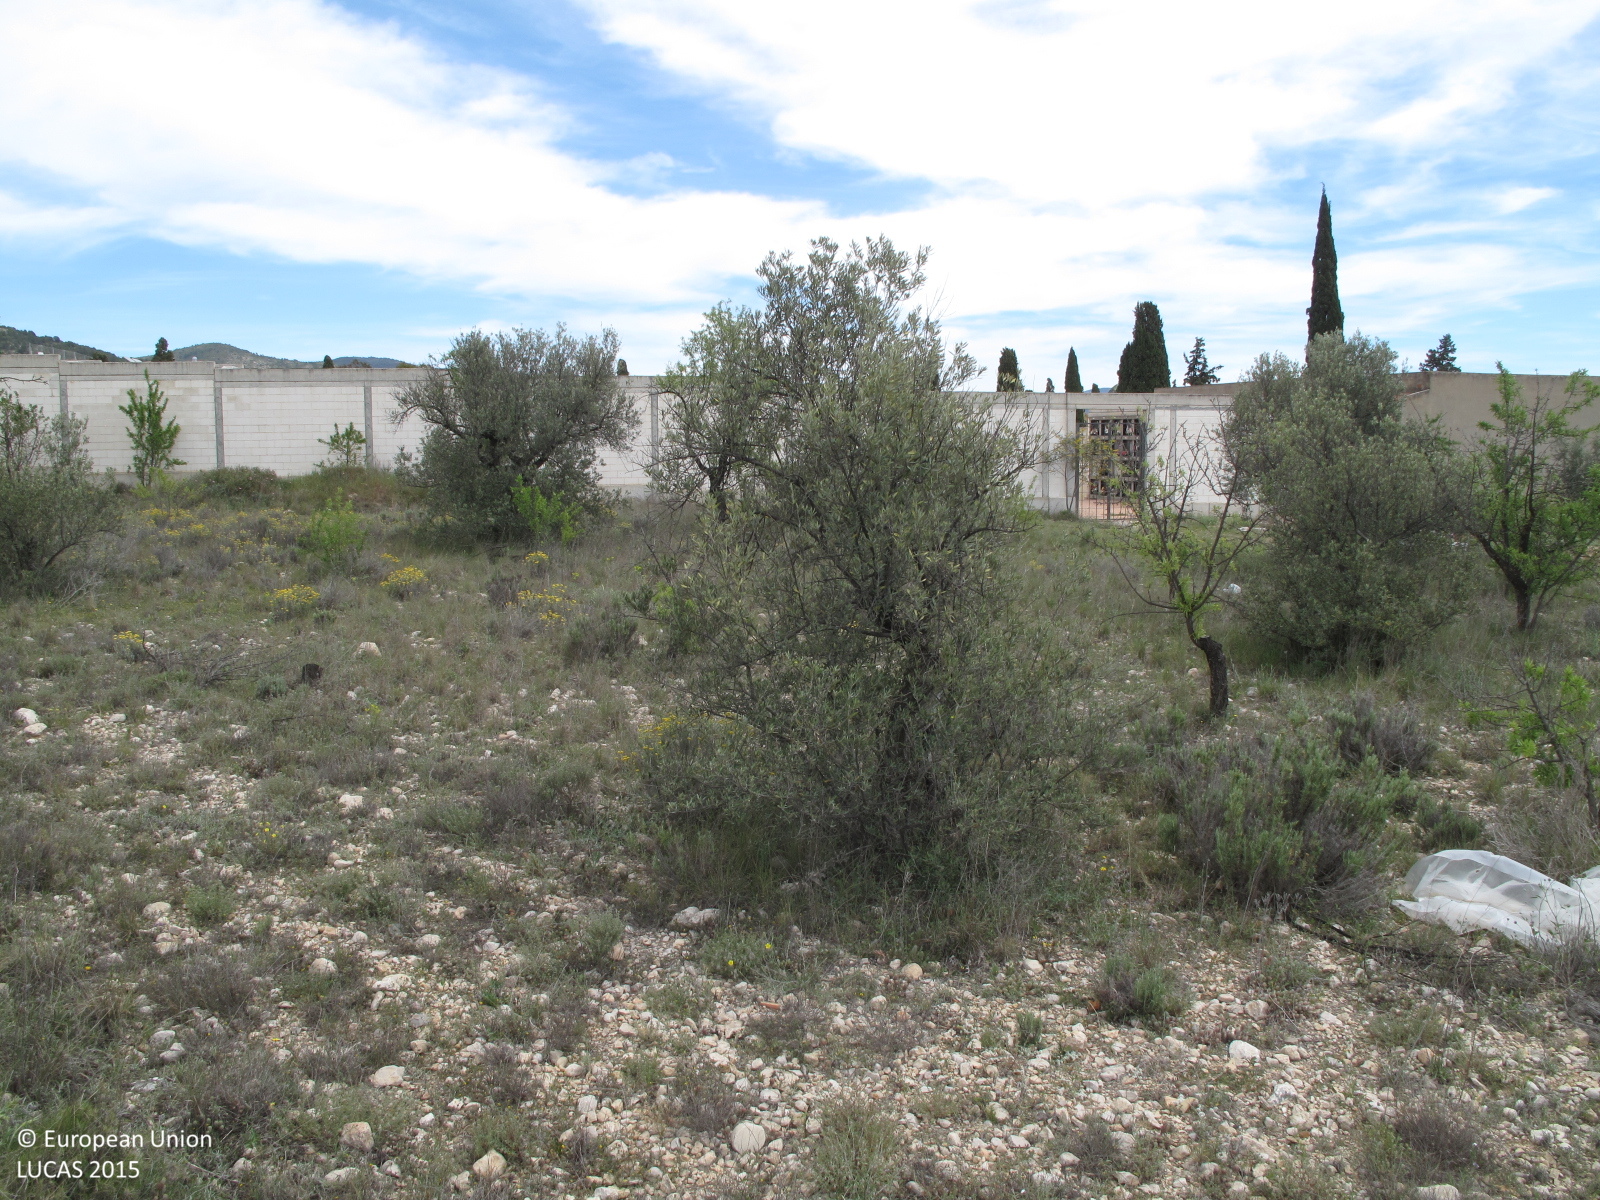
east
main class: Cropland
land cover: Olive groves
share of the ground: < 10 %
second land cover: Nuts trees
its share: < 10 %
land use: Agriculture (excluding fallow land and kitchen gardens)
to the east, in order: Olive groves; Nuts trees; Tracks; Grassland with sparse tree/shrub cover; Artificial constructions in urban areas; Other bare soil; Lines of trees; Other bare soil; Lines of trees; Fences; Pine dominated coniferous woodland
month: April
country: ES
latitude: 38.6239
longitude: -0.6829
